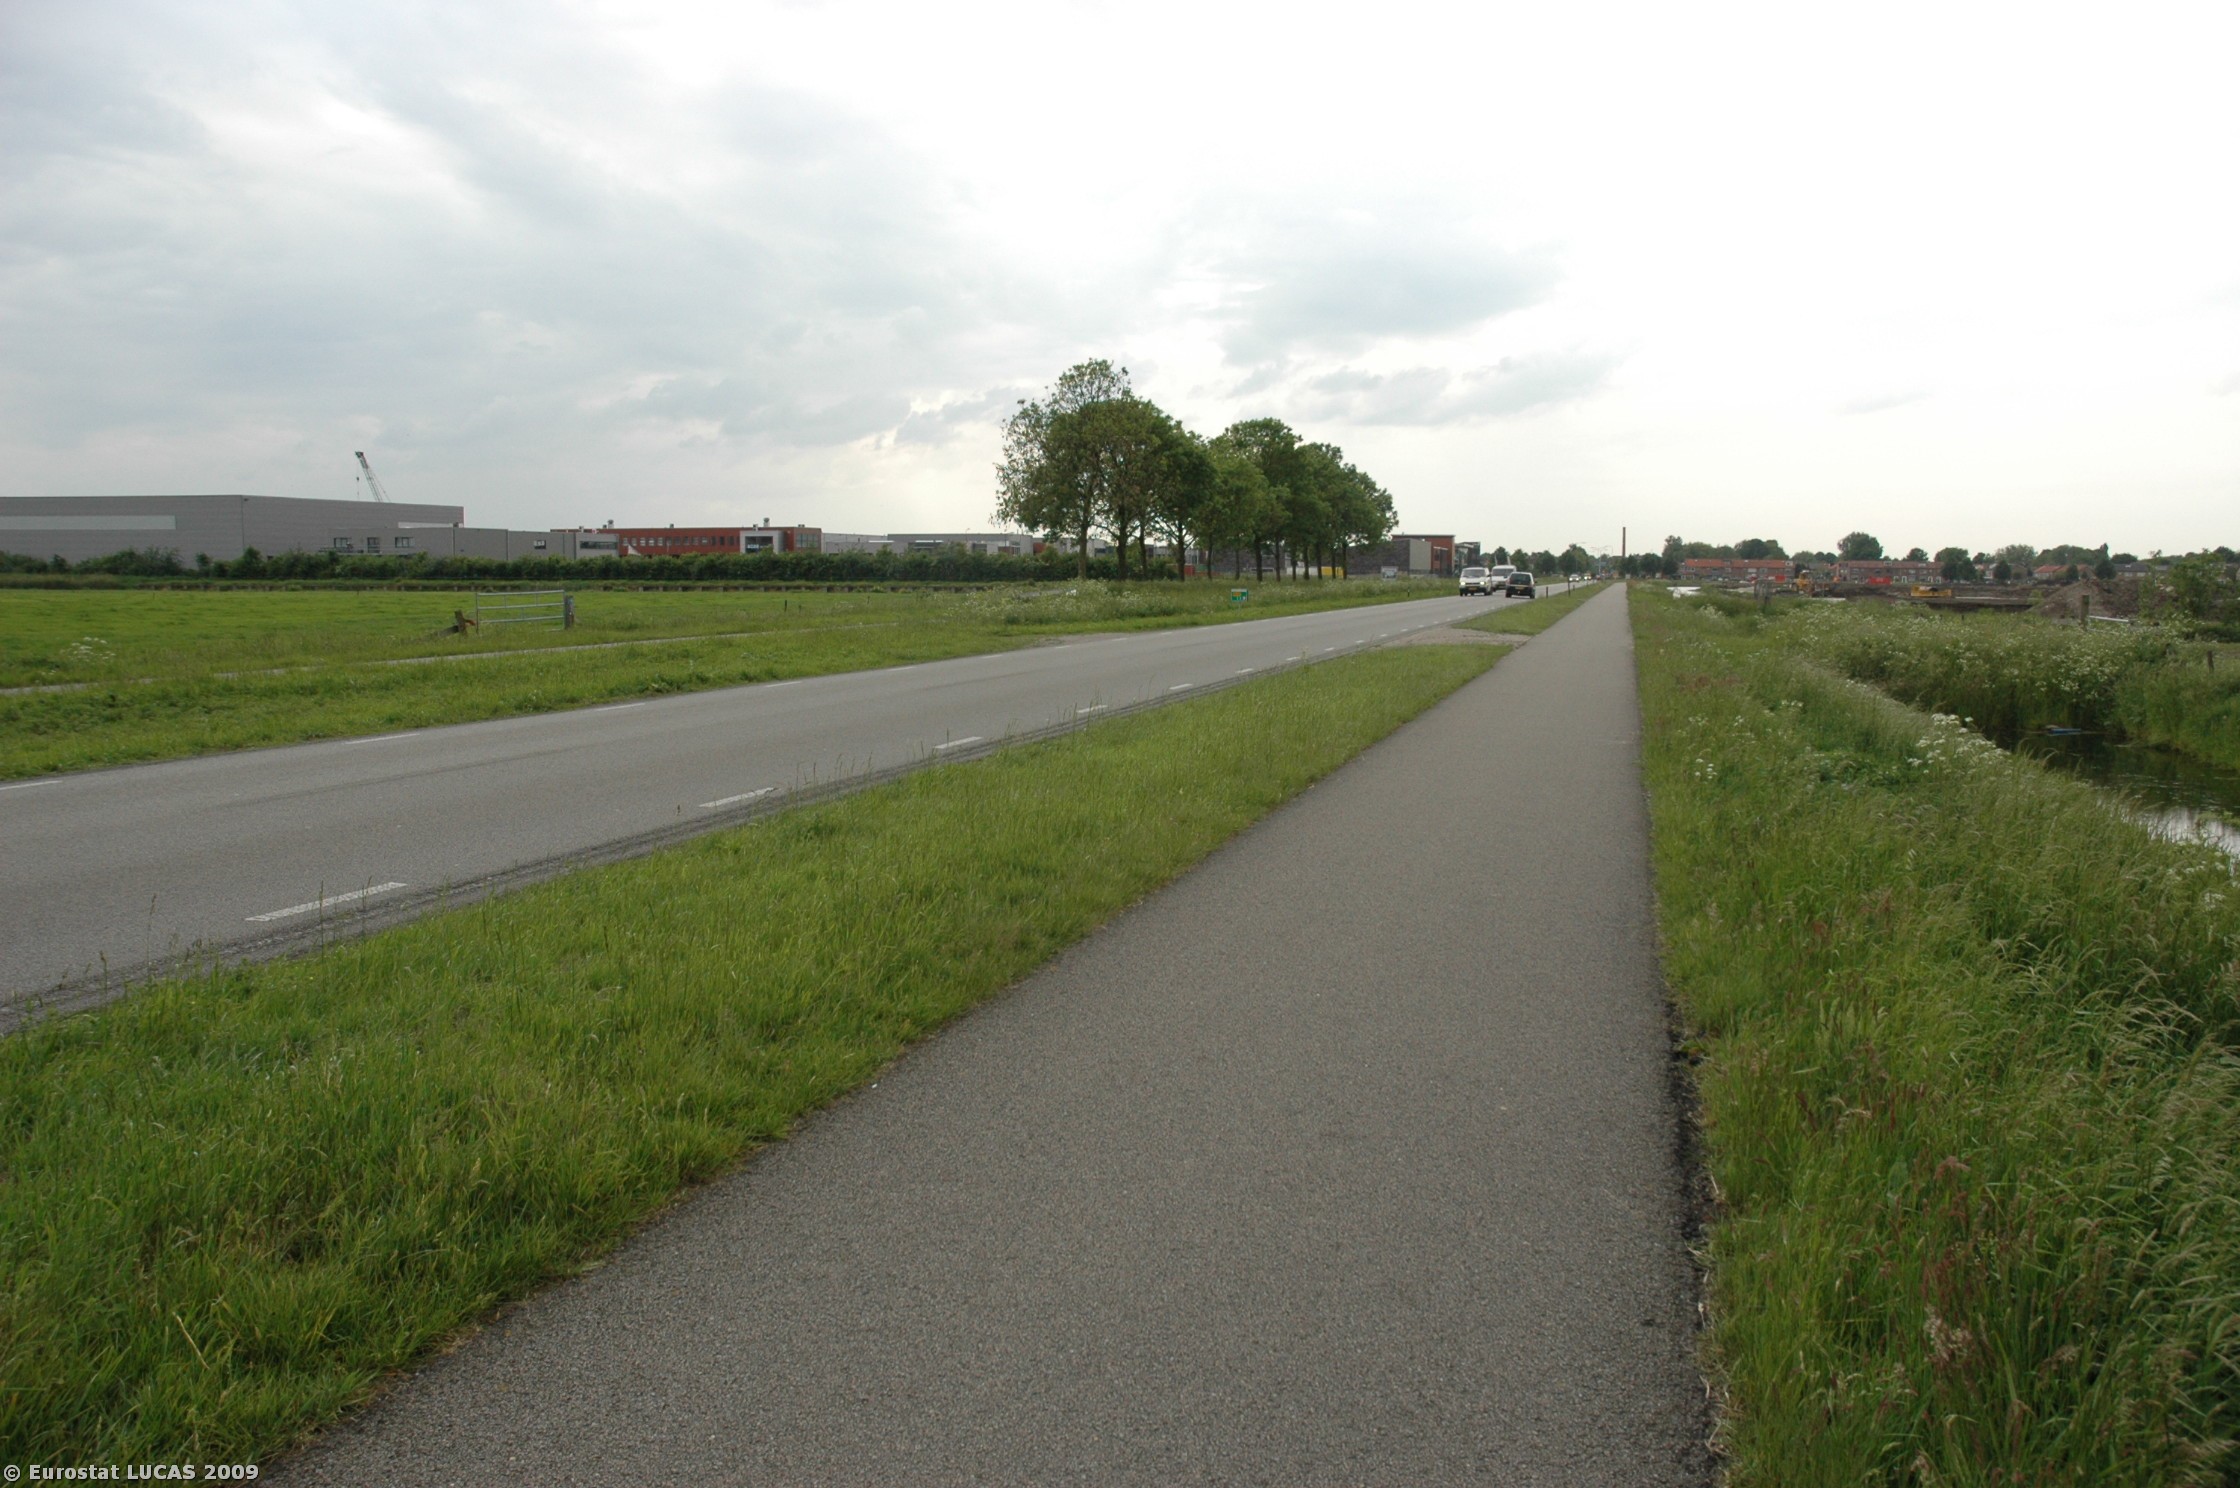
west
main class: Grassland
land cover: Grassland without tree/shrub cover
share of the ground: > 75 %
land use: Agriculture (excluding fallow land and kitchen gardens)
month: May
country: NL
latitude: 52.2338
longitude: 5.3858
